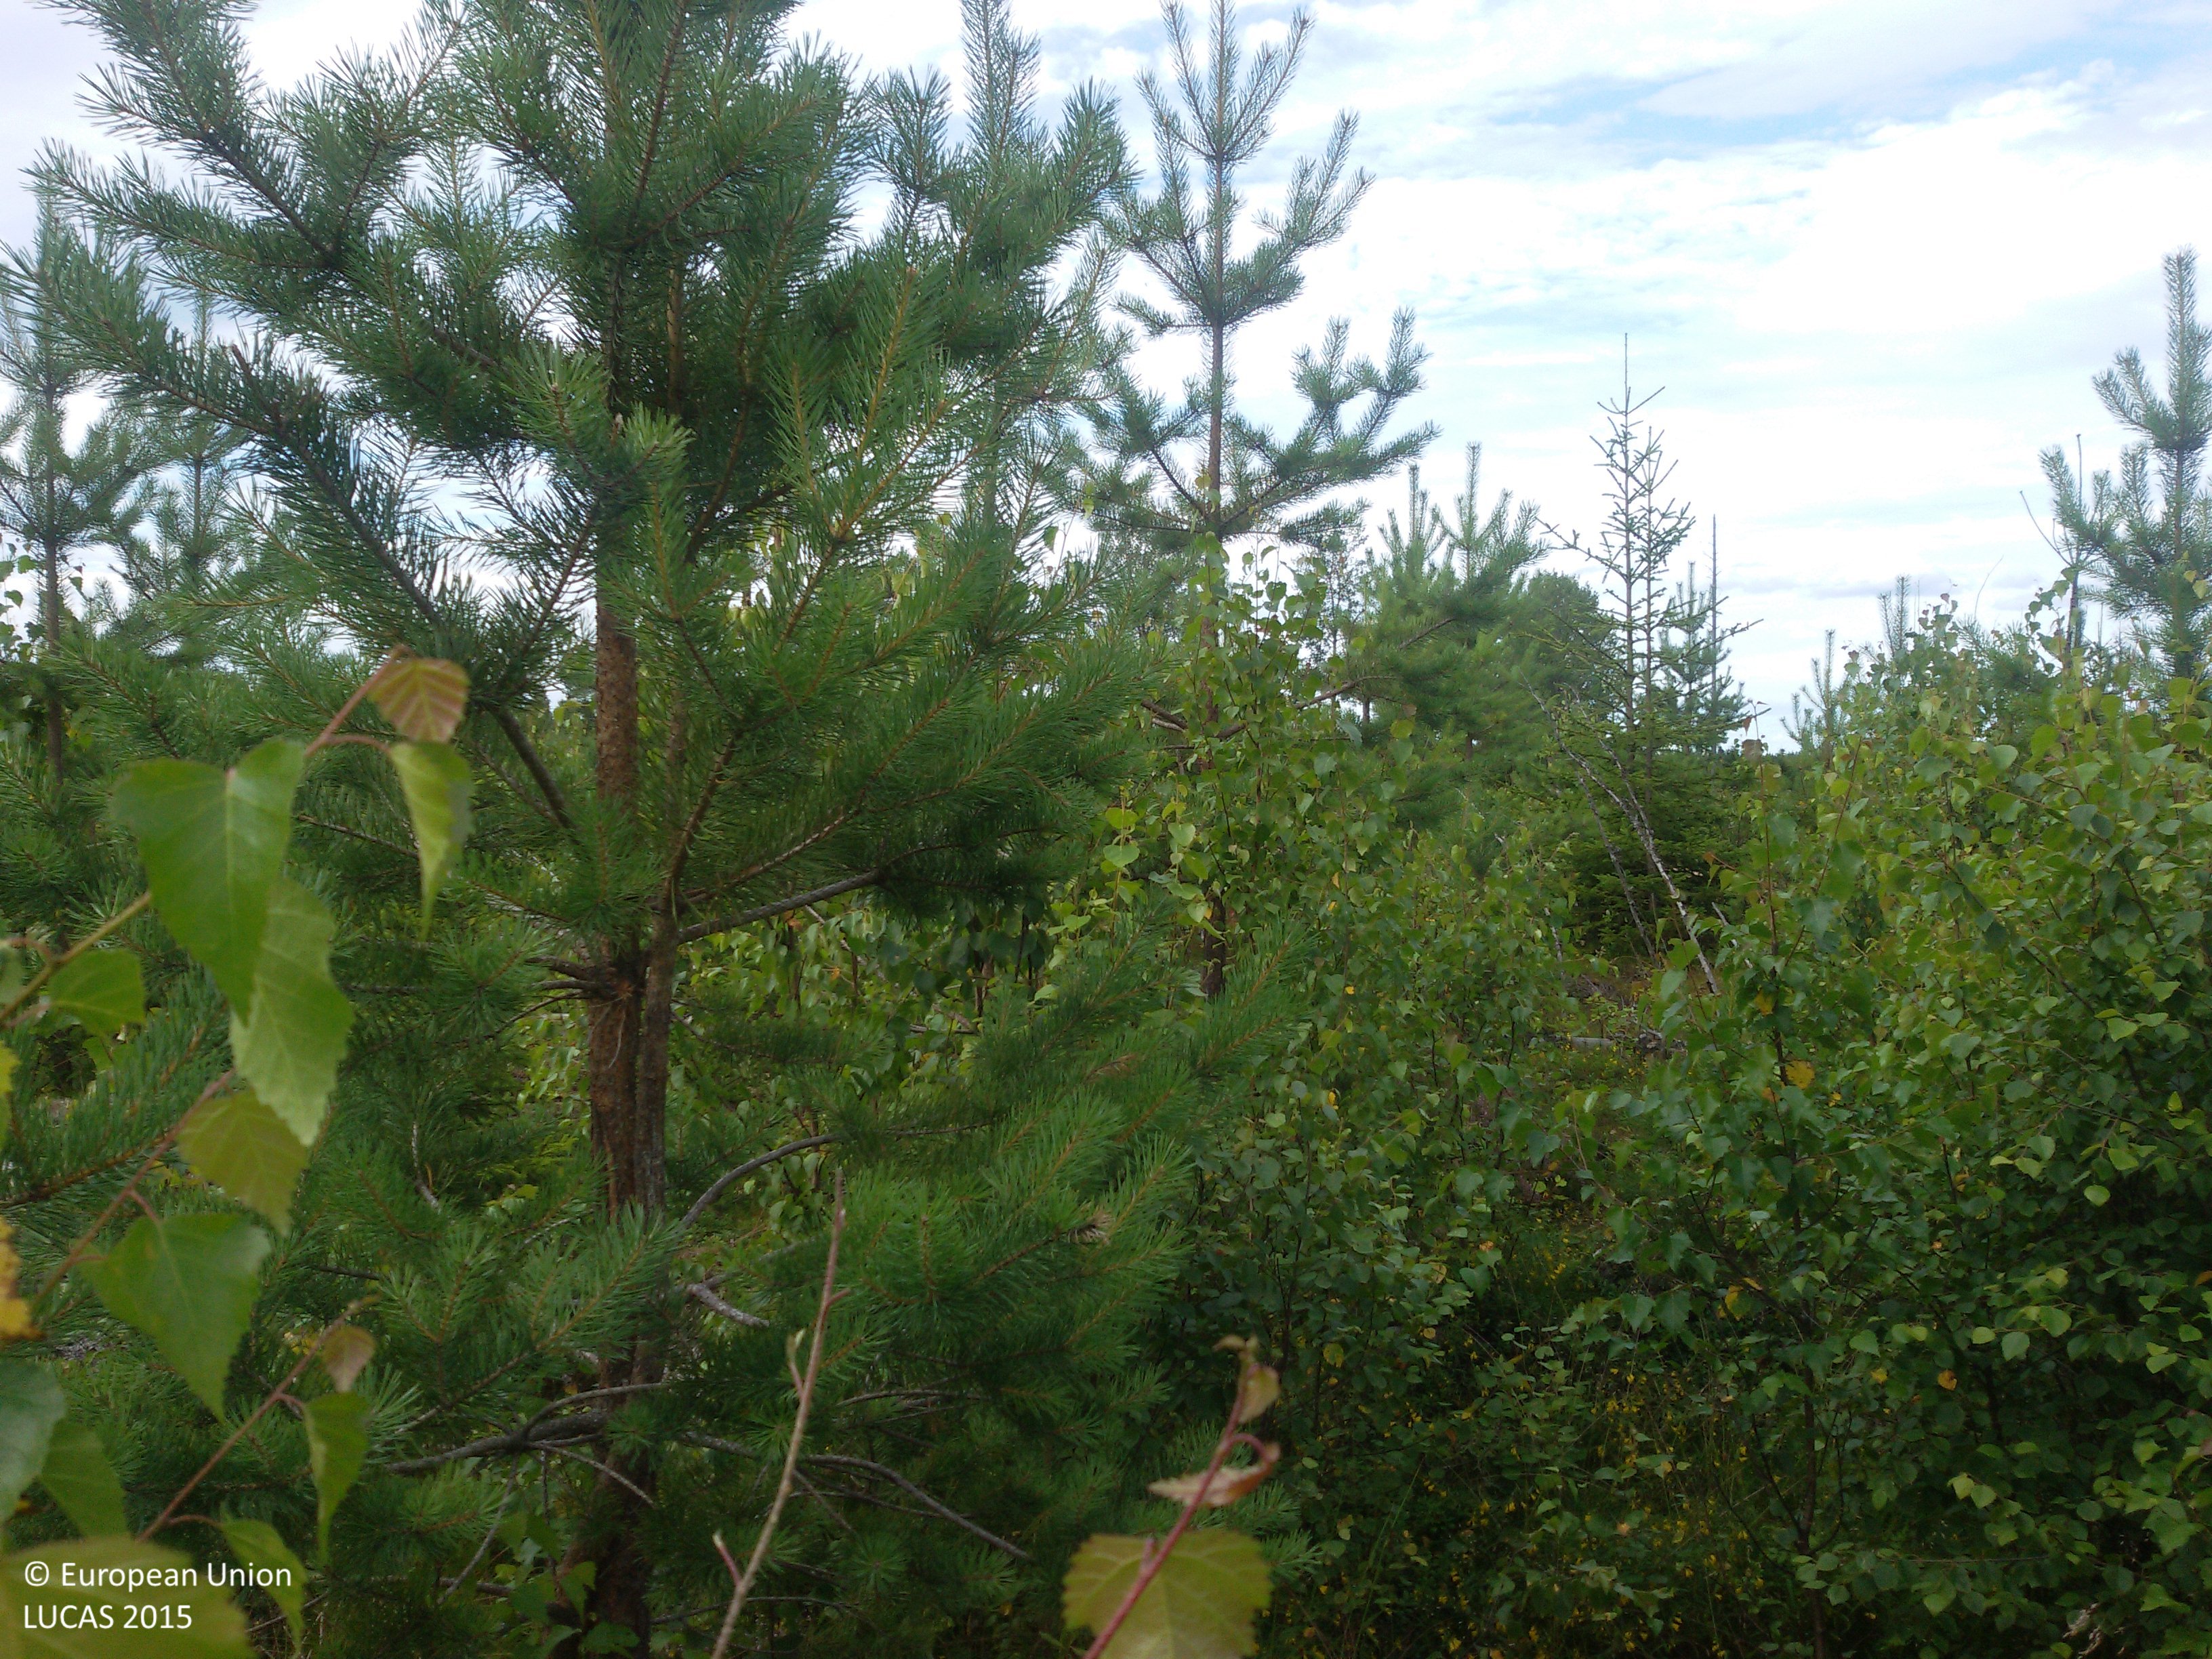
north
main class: Woodland
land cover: Pine dominated mixed woodland
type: boreal forest
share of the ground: > 75 %
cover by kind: coniferous forest trees 45 %, broadleaved forest trees 40 %, herbaceous plants 15 %
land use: Forestry
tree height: < 5 m
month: August
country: SE
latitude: 60.4100
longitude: 16.5067
